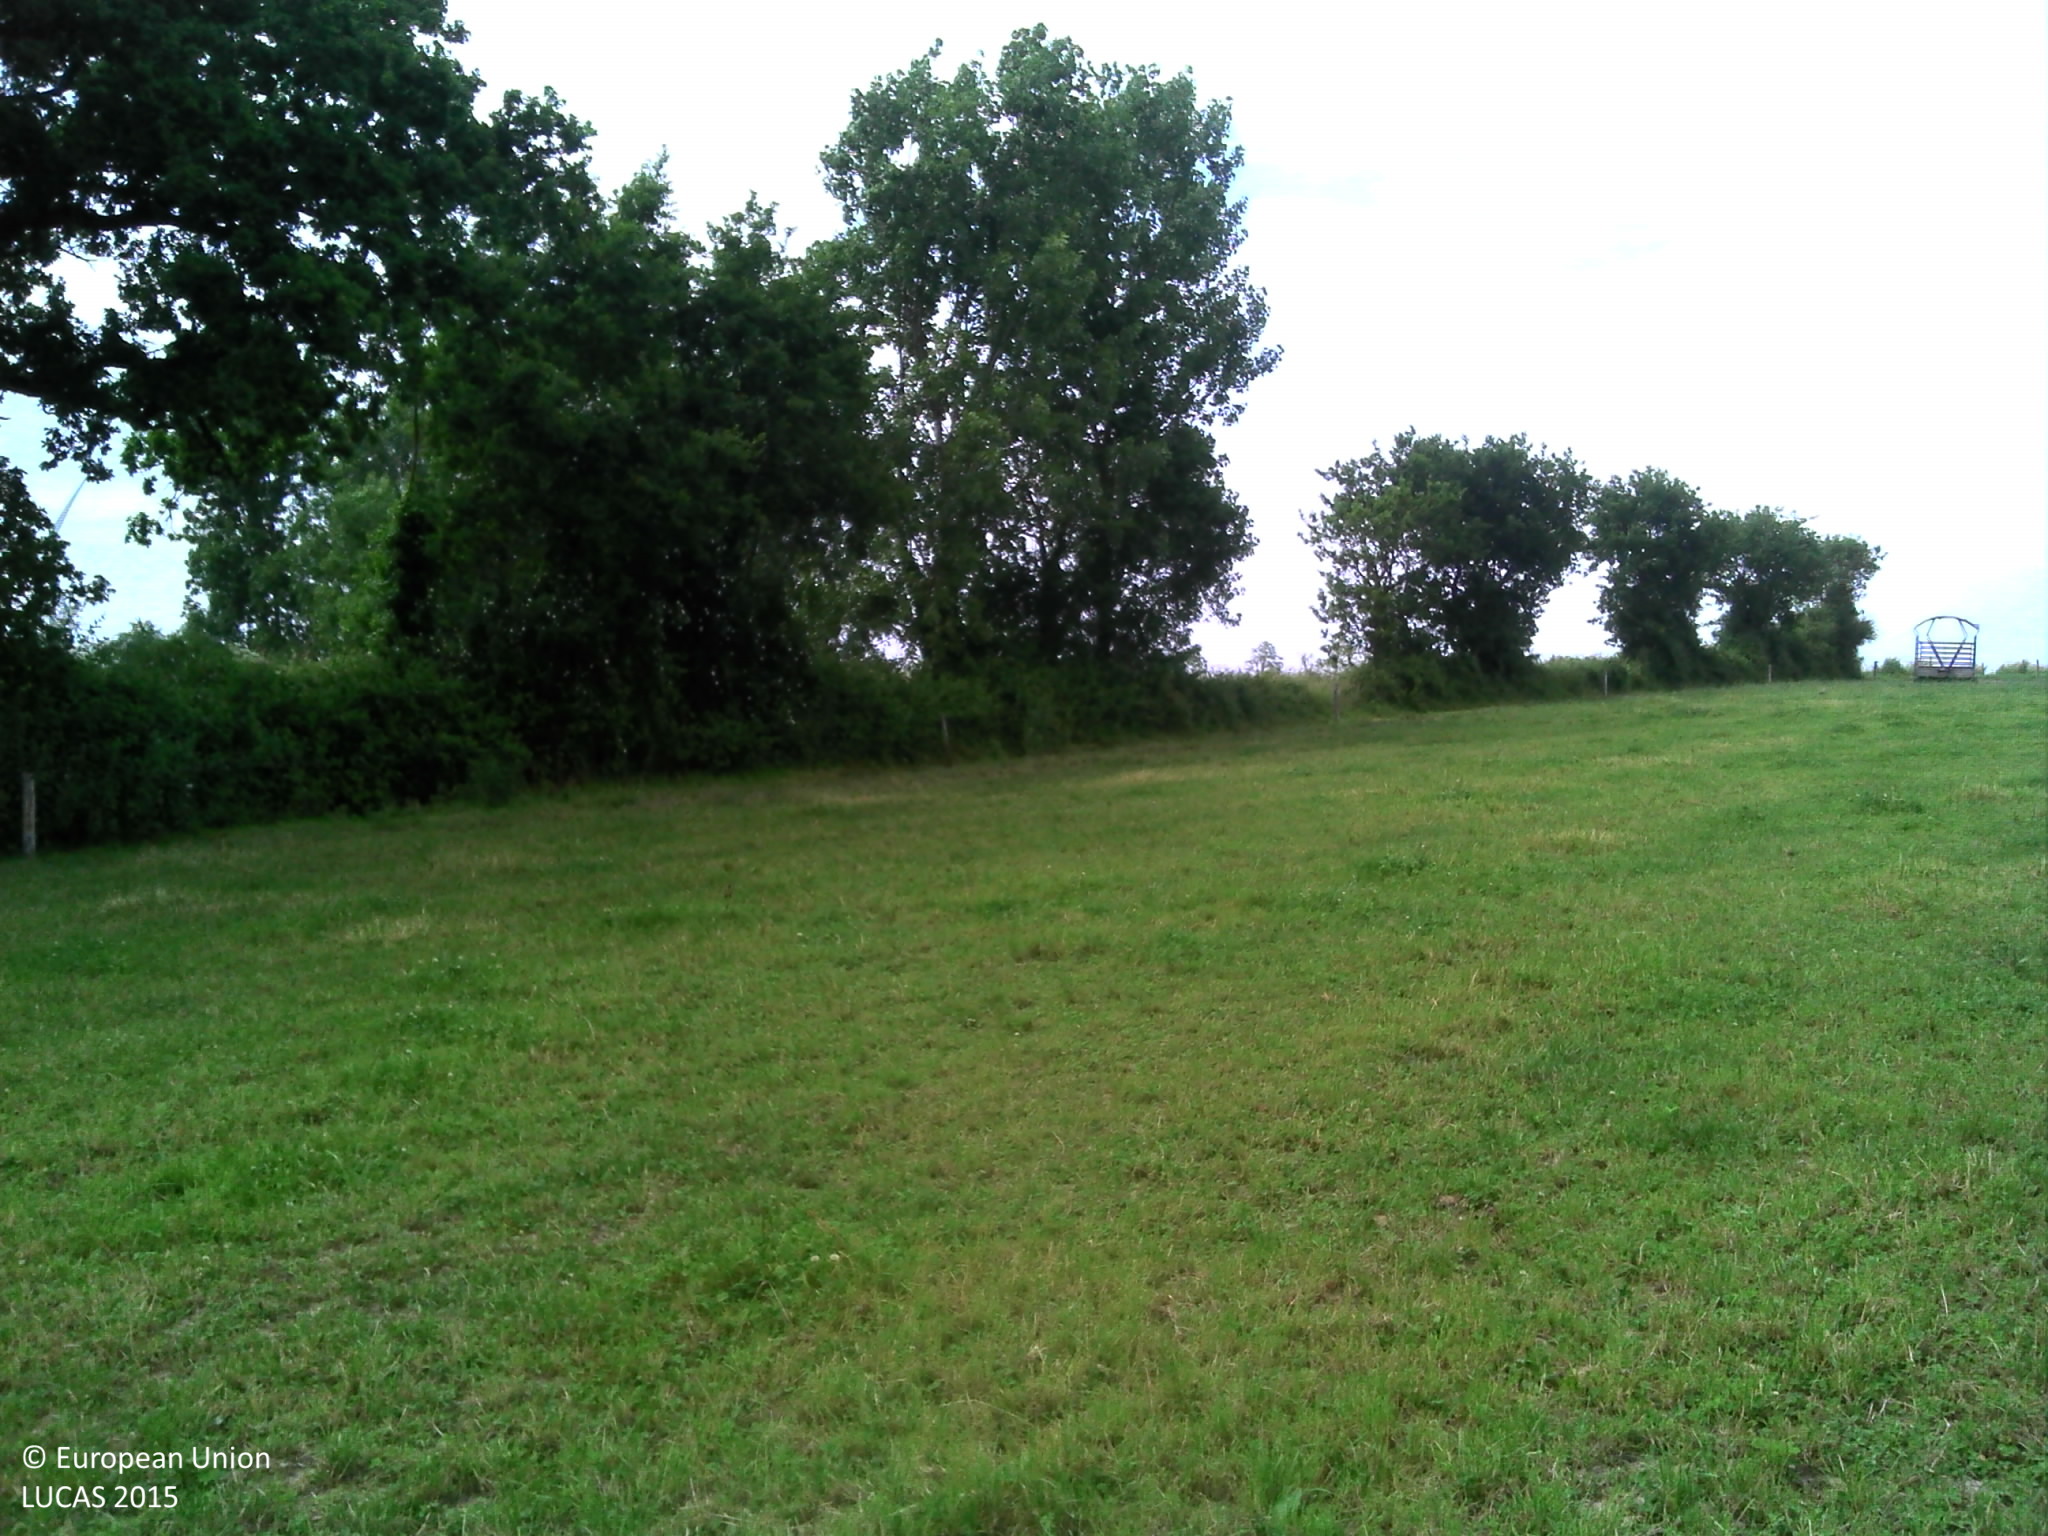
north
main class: Grassland
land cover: Grassland without tree/shrub cover
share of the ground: > 75 %
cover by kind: herbaceous plants 100 %
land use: Agriculture (excluding fallow land and kitchen gardens)
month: June
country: FR
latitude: 46.7814
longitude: -1.6857
